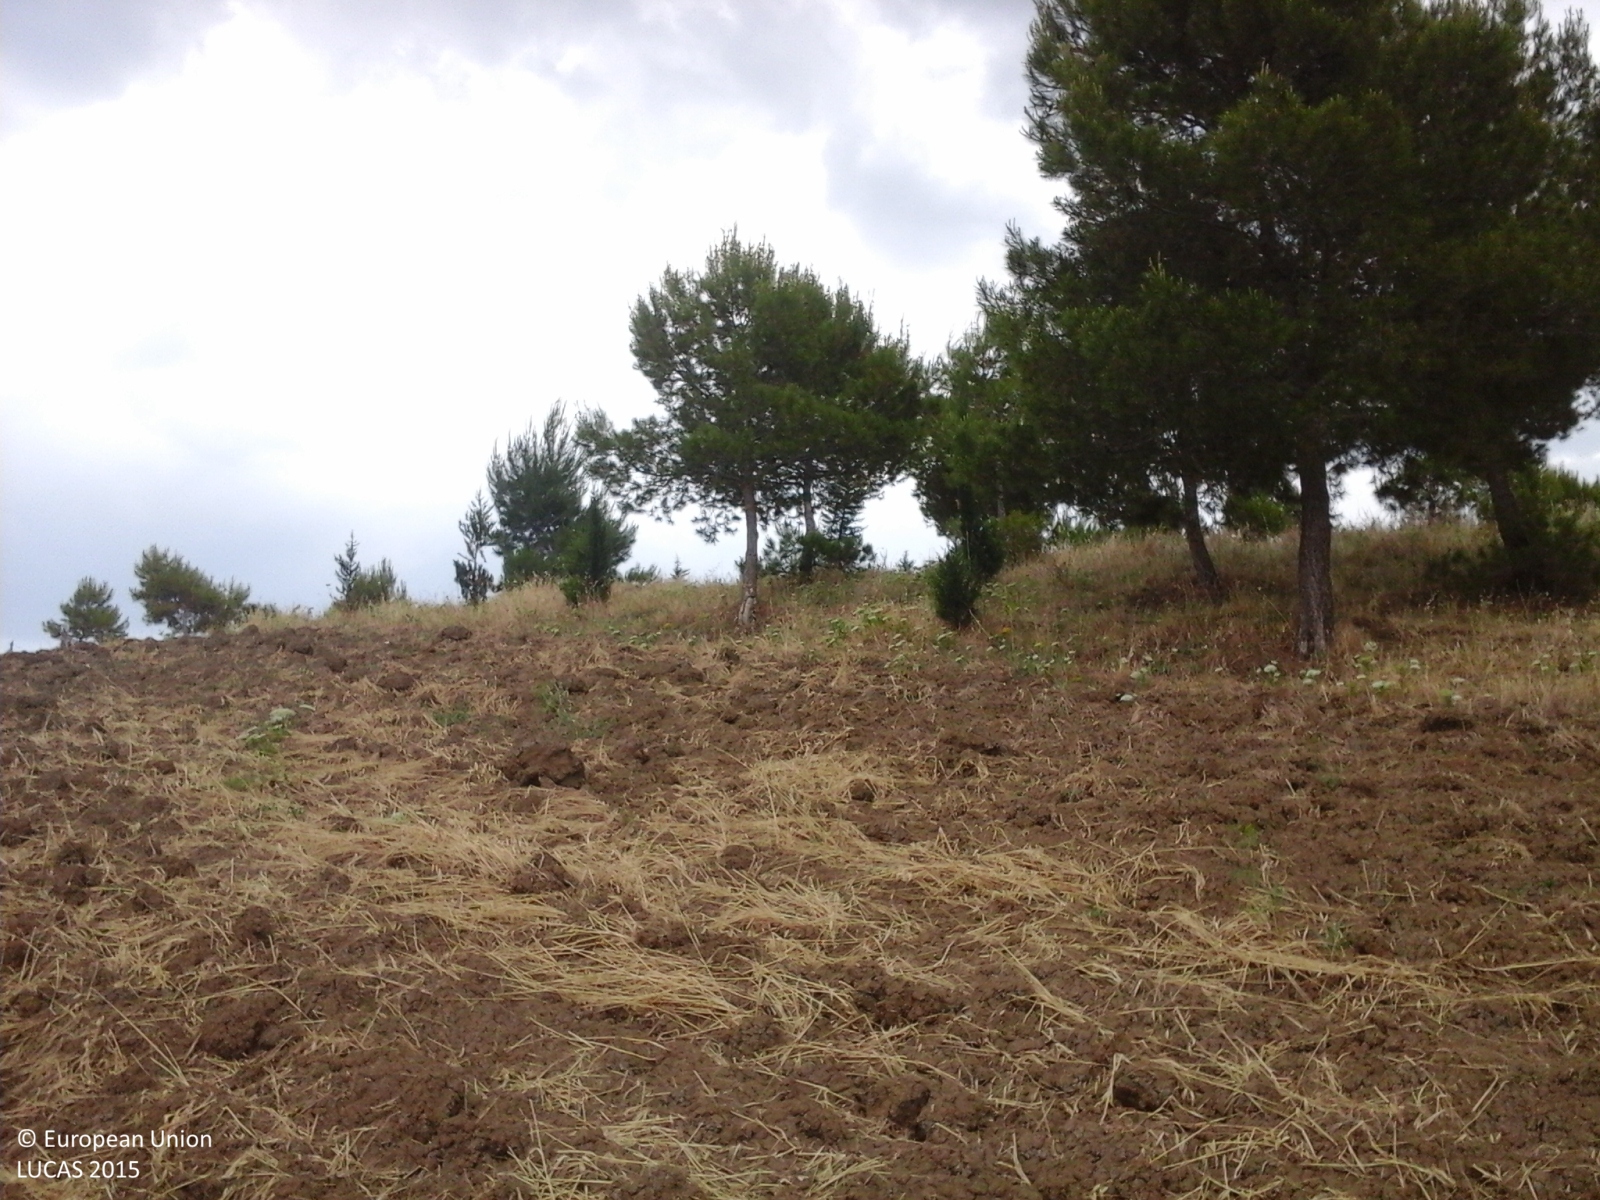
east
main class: Woodland
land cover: Broadleaved woodland
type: broadleaved evergreen forest
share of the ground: 10 - 25 %
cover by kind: herbaceous plants 80 %, broadleaved forest trees 20 %
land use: Forestry
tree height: < 5 m
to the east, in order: Broadleaved woodland; Other bare soil; Fences; Other bare soil; Other coniferous woodland; Other bare soil; Fences; Grass margins; Paved roads, cycling and walking lanes; Grassland without tree/shrub cover; Fences; Grass margins; Durum wheat
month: June
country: IT
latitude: 37.5176
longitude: 14.0092
